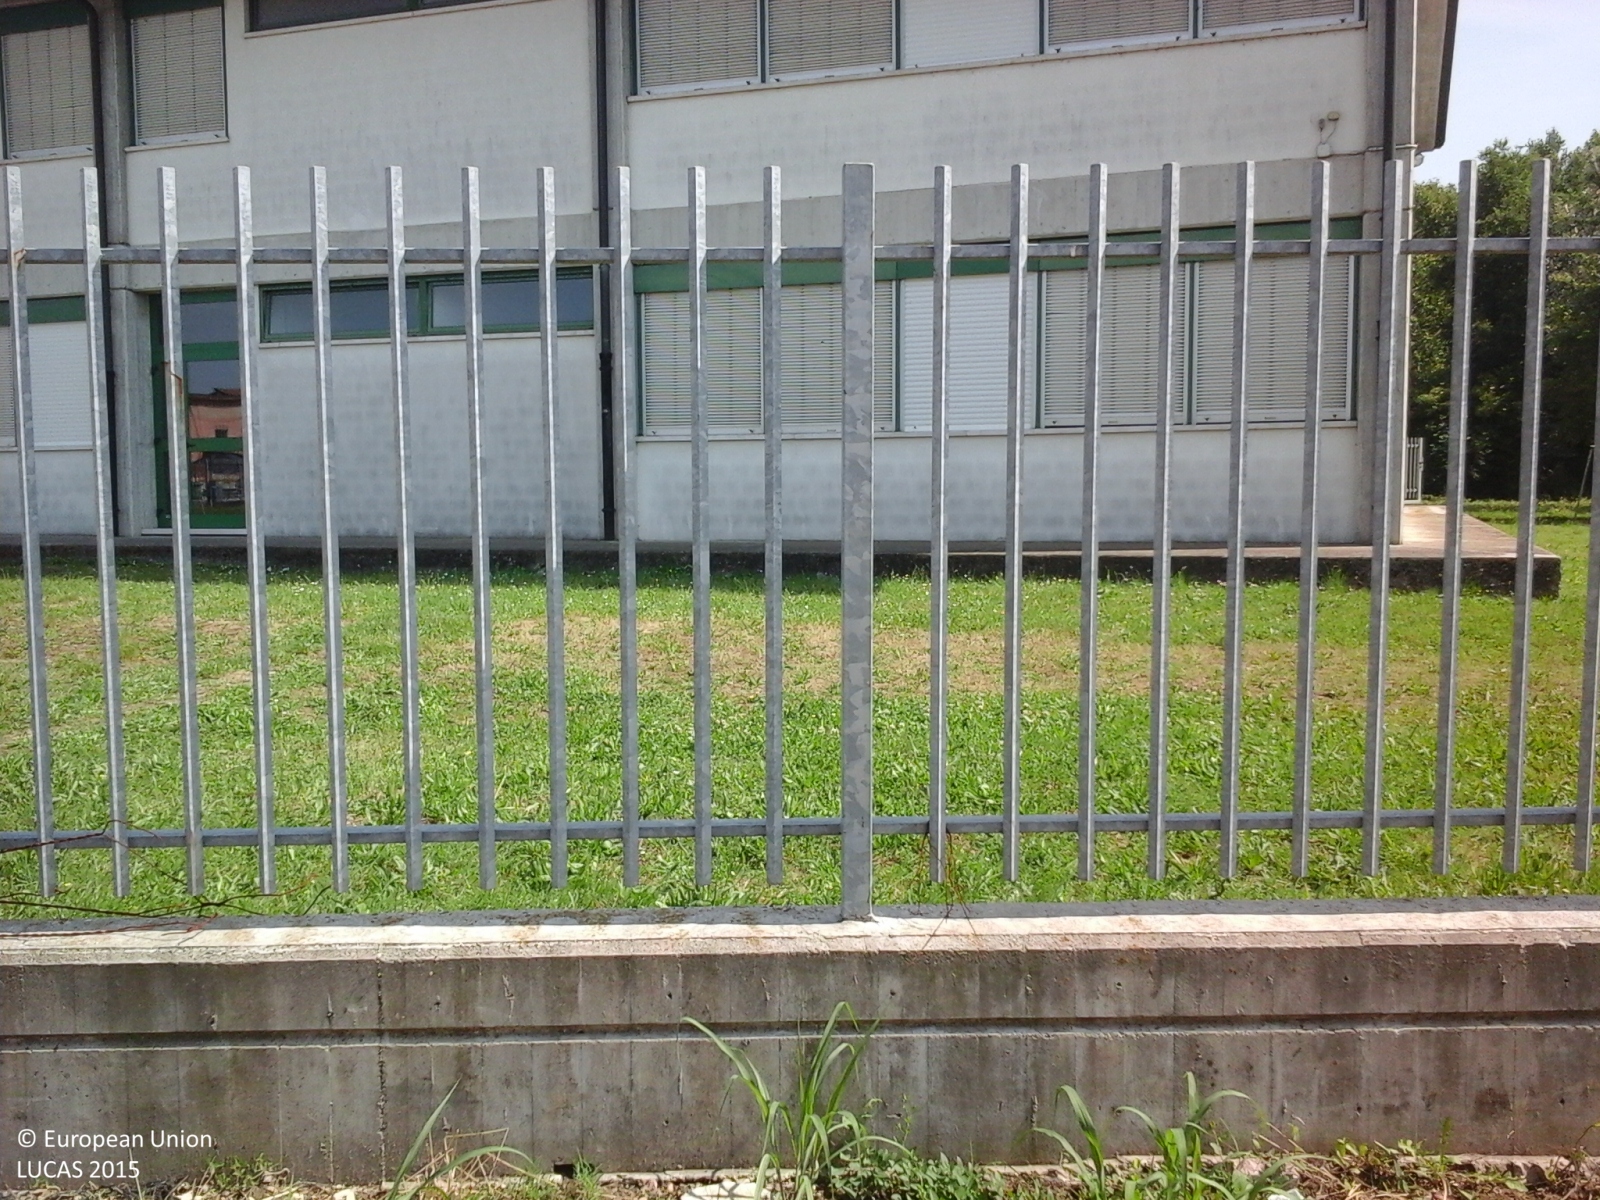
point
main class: Grassland
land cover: Grassland without tree/shrub cover
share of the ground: > 75 %
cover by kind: herbaceous plants 100 %
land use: Community services
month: May
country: IT
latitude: 45.2115
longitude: 10.9786
